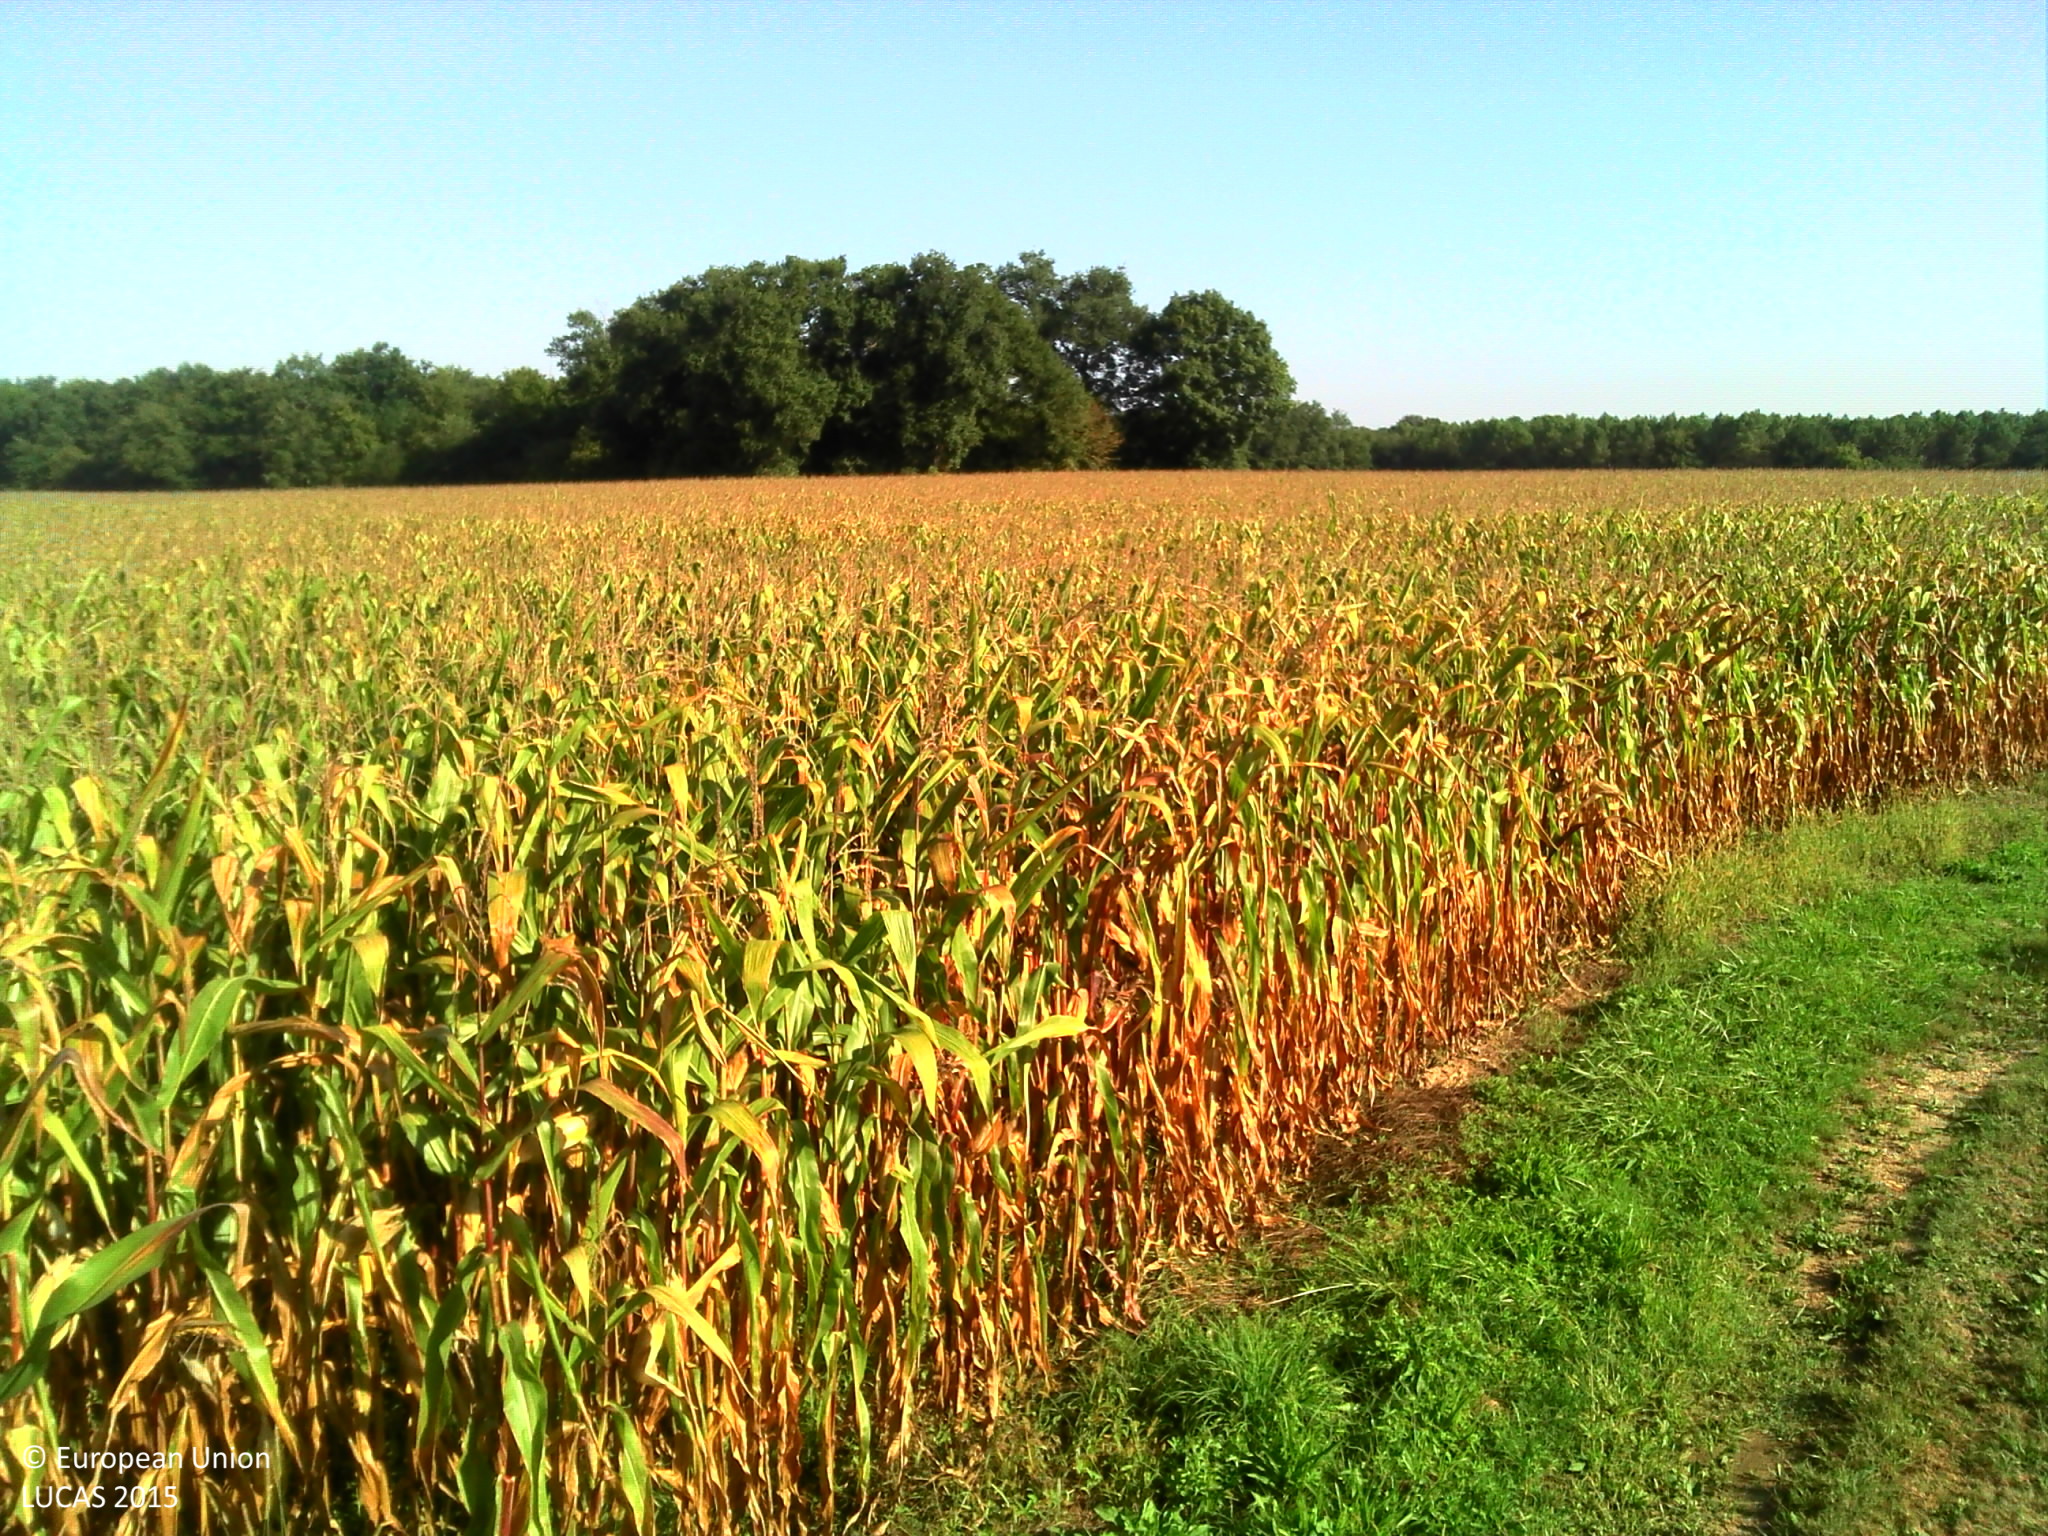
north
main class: Cropland
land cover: Maize
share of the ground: > 75 %
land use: Agriculture (excluding fallow land and kitchen gardens)
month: September
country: FR
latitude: 43.5547
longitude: -0.7440
